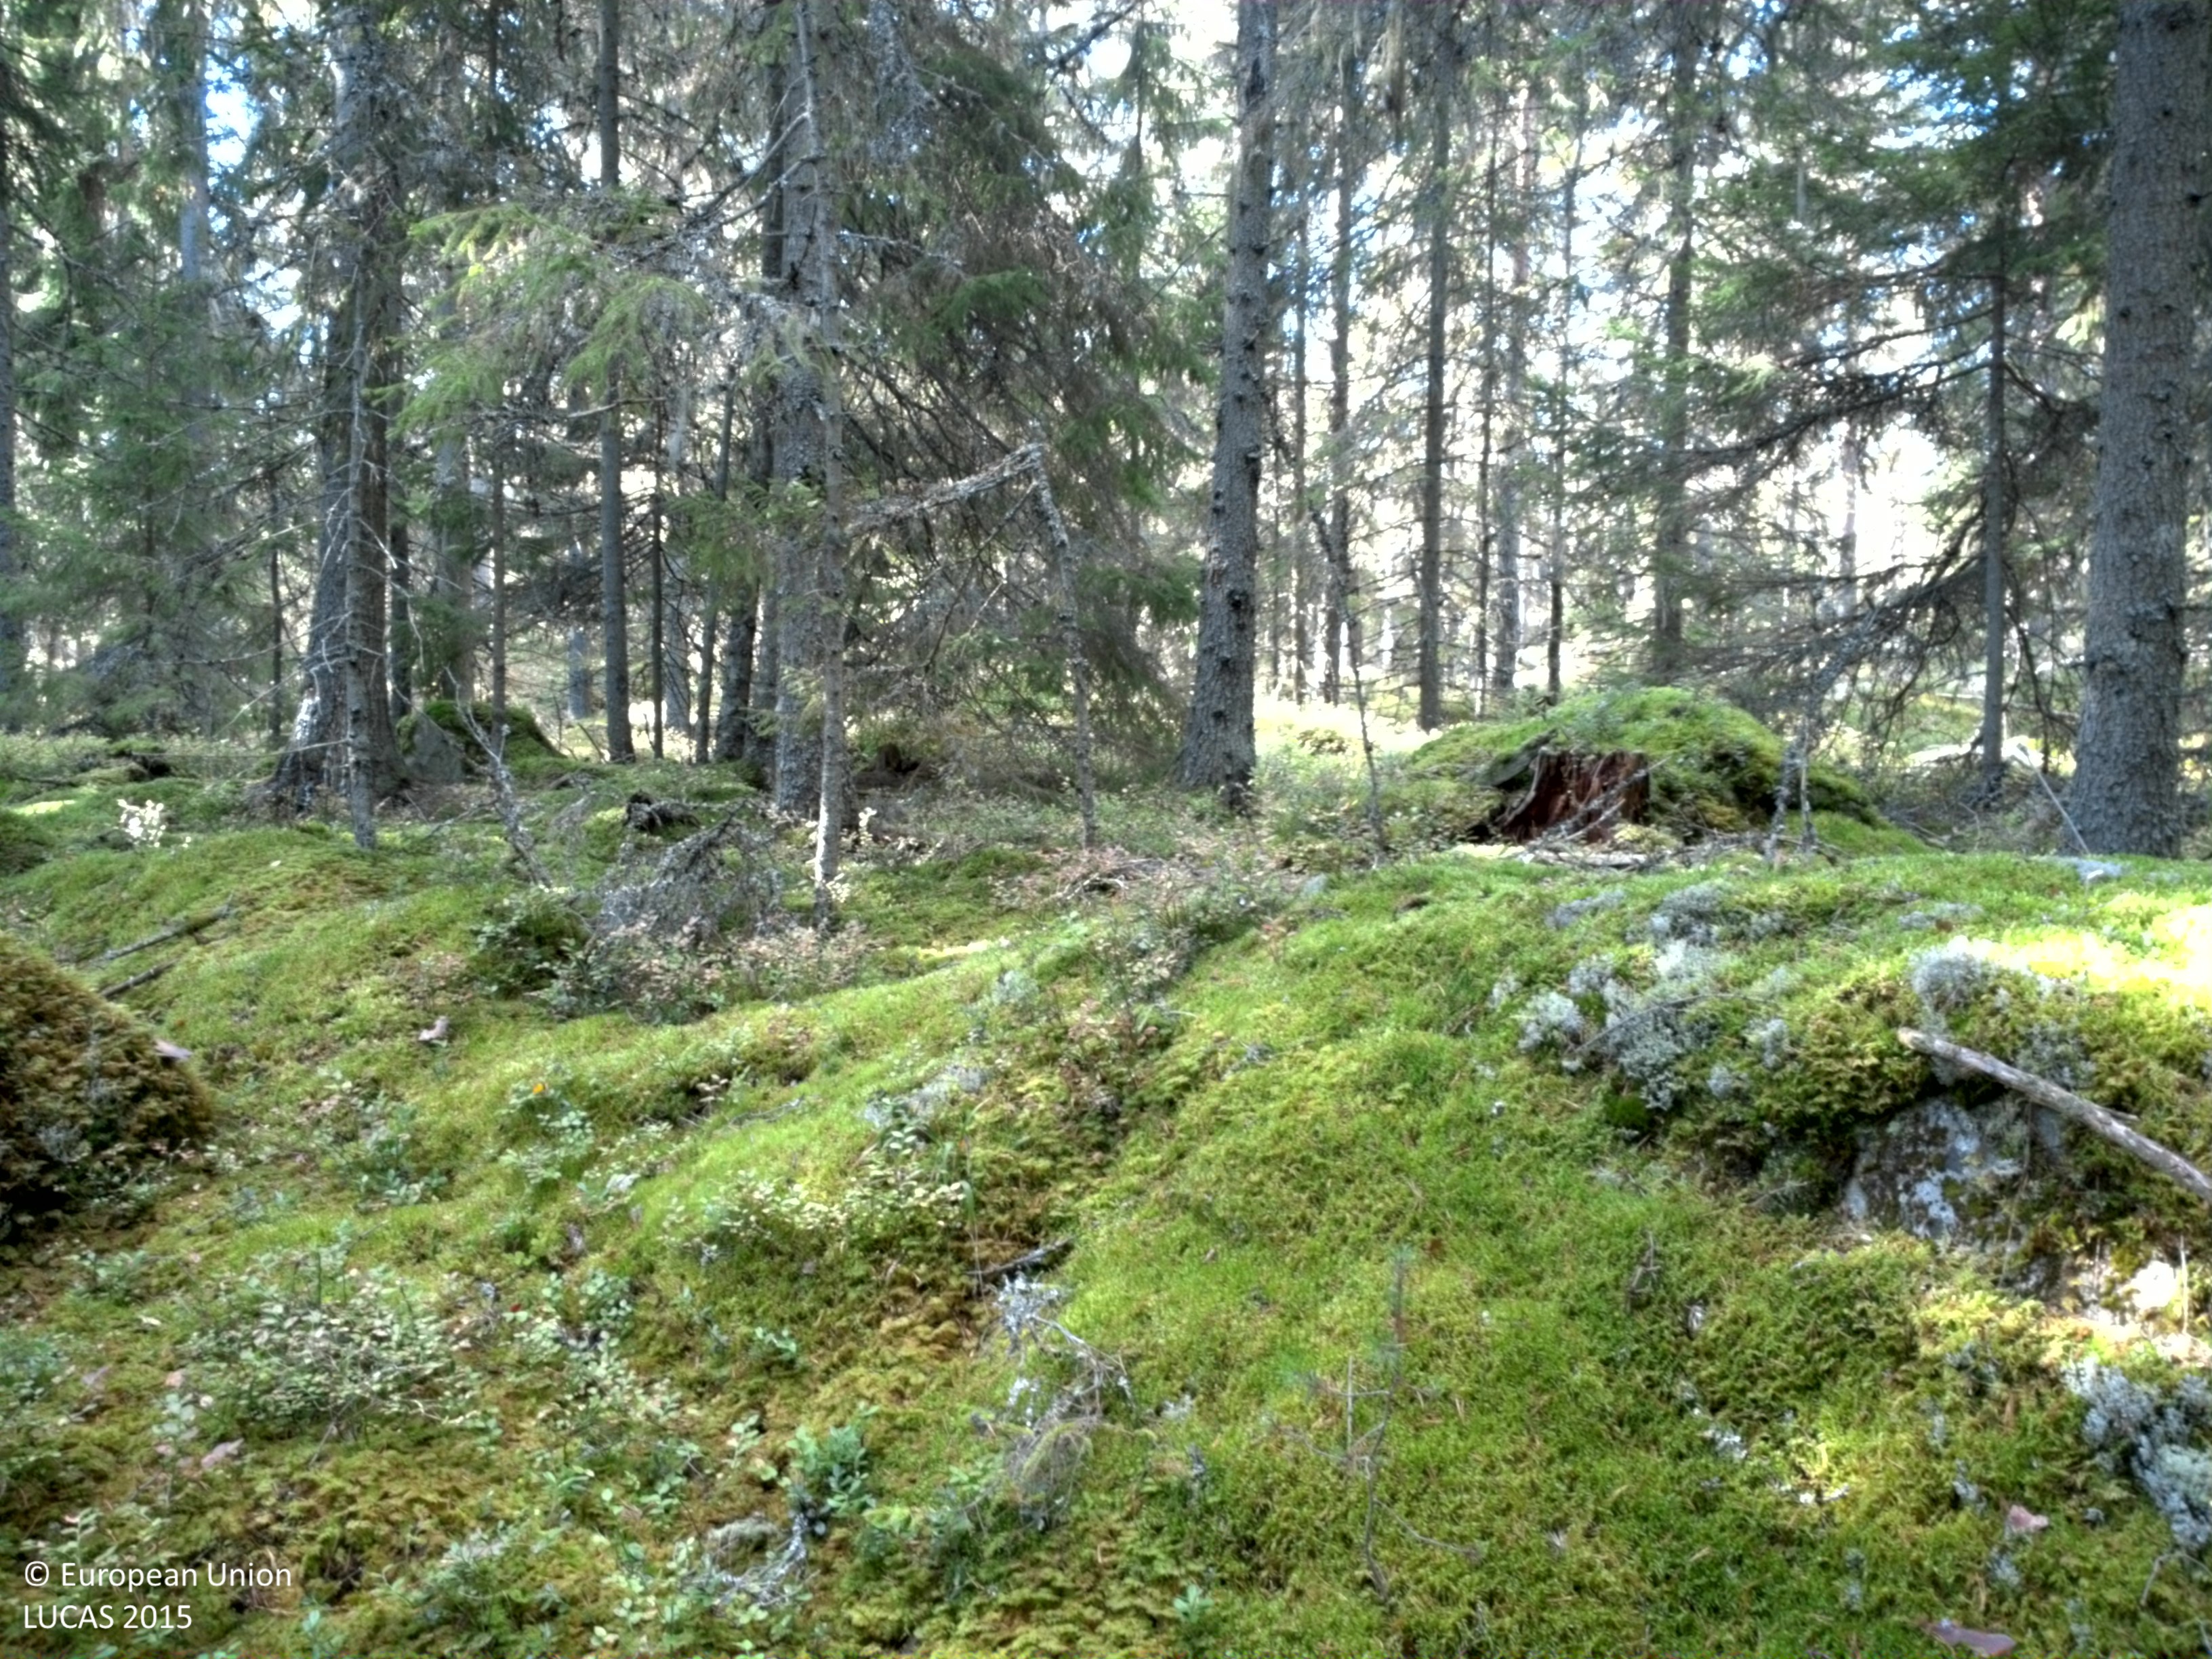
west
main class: Woodland
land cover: Spruce dominated coniferous woodland
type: boreal forest
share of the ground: > 75 %
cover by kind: coniferous forest trees 75 %, lichens and mosses 25 %
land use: Forestry
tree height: > 5 m
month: September
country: SE
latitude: 60.1543
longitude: 16.5652
